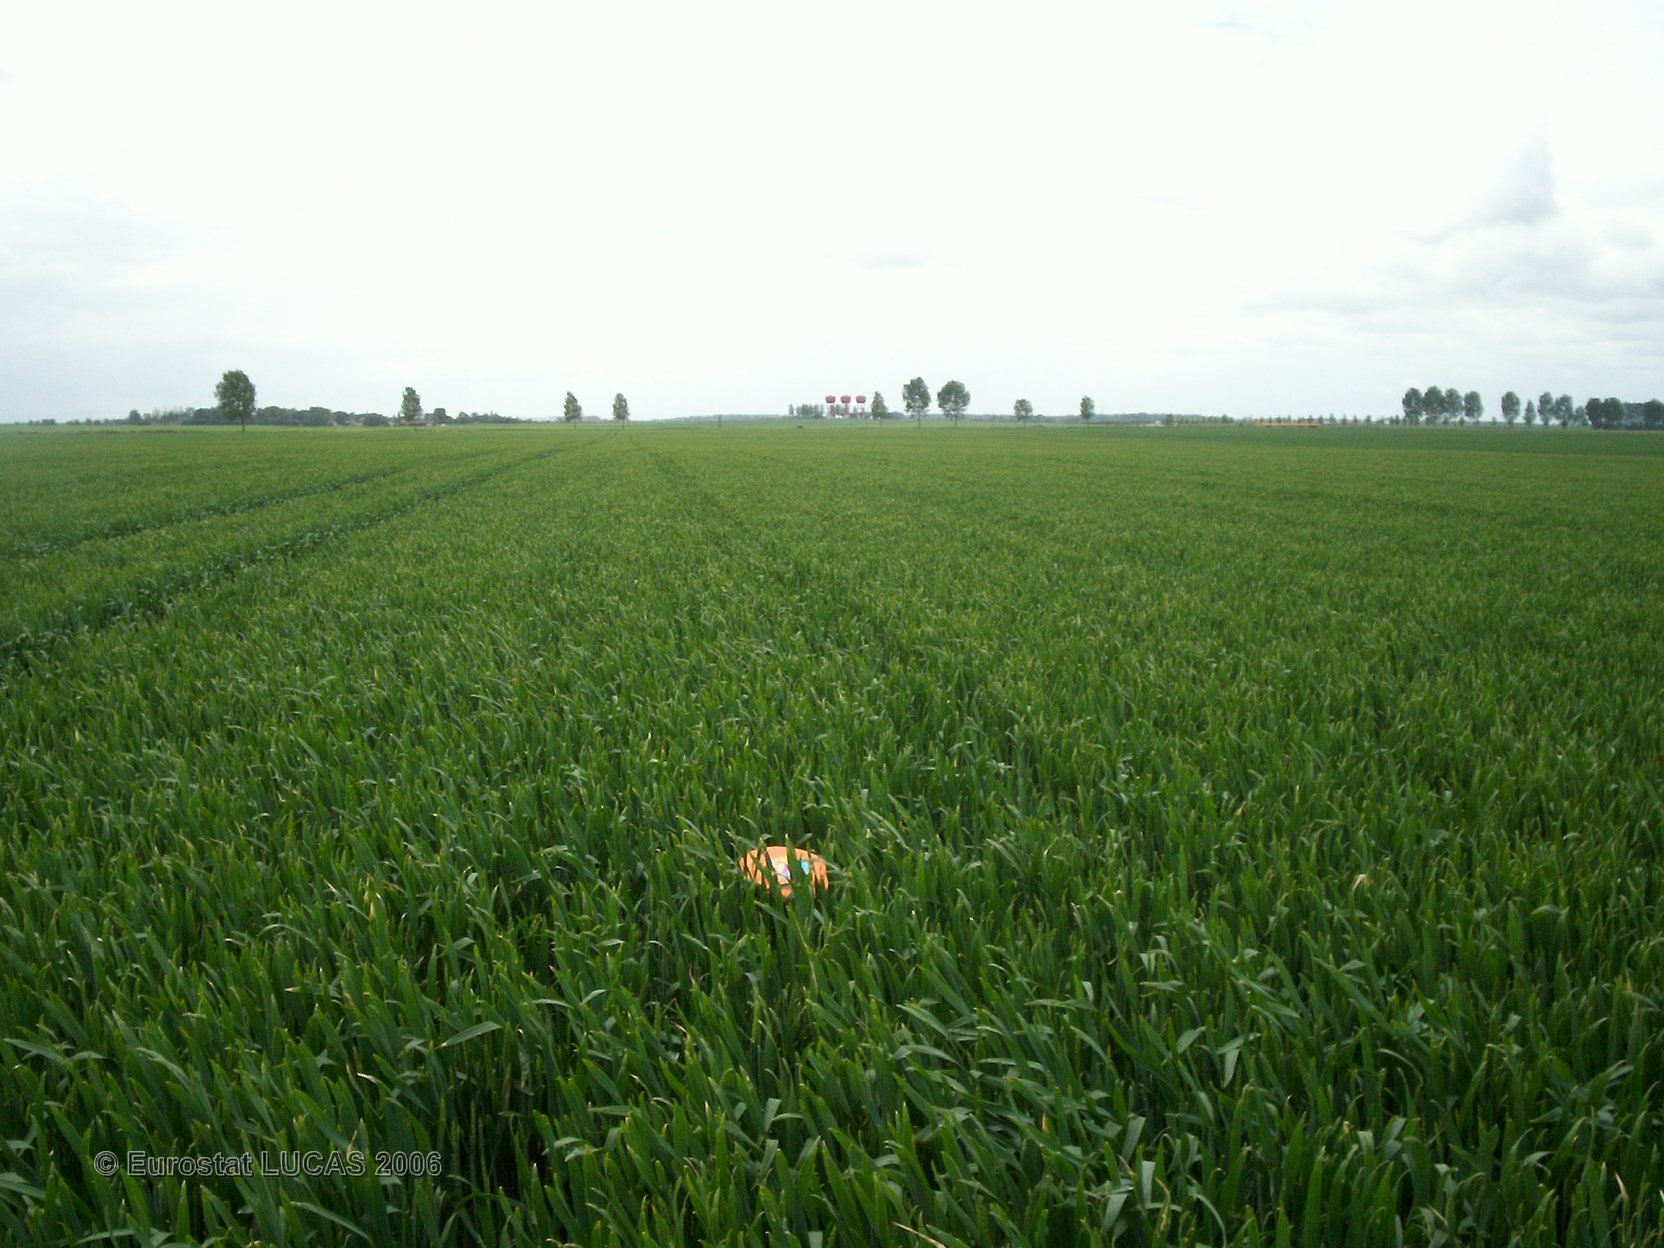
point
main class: Cropland
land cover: Common wheat
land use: Agriculture (excluding fallow land and kitchen gardens)
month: May
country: FR
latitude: 49.8571
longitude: 2.6581
